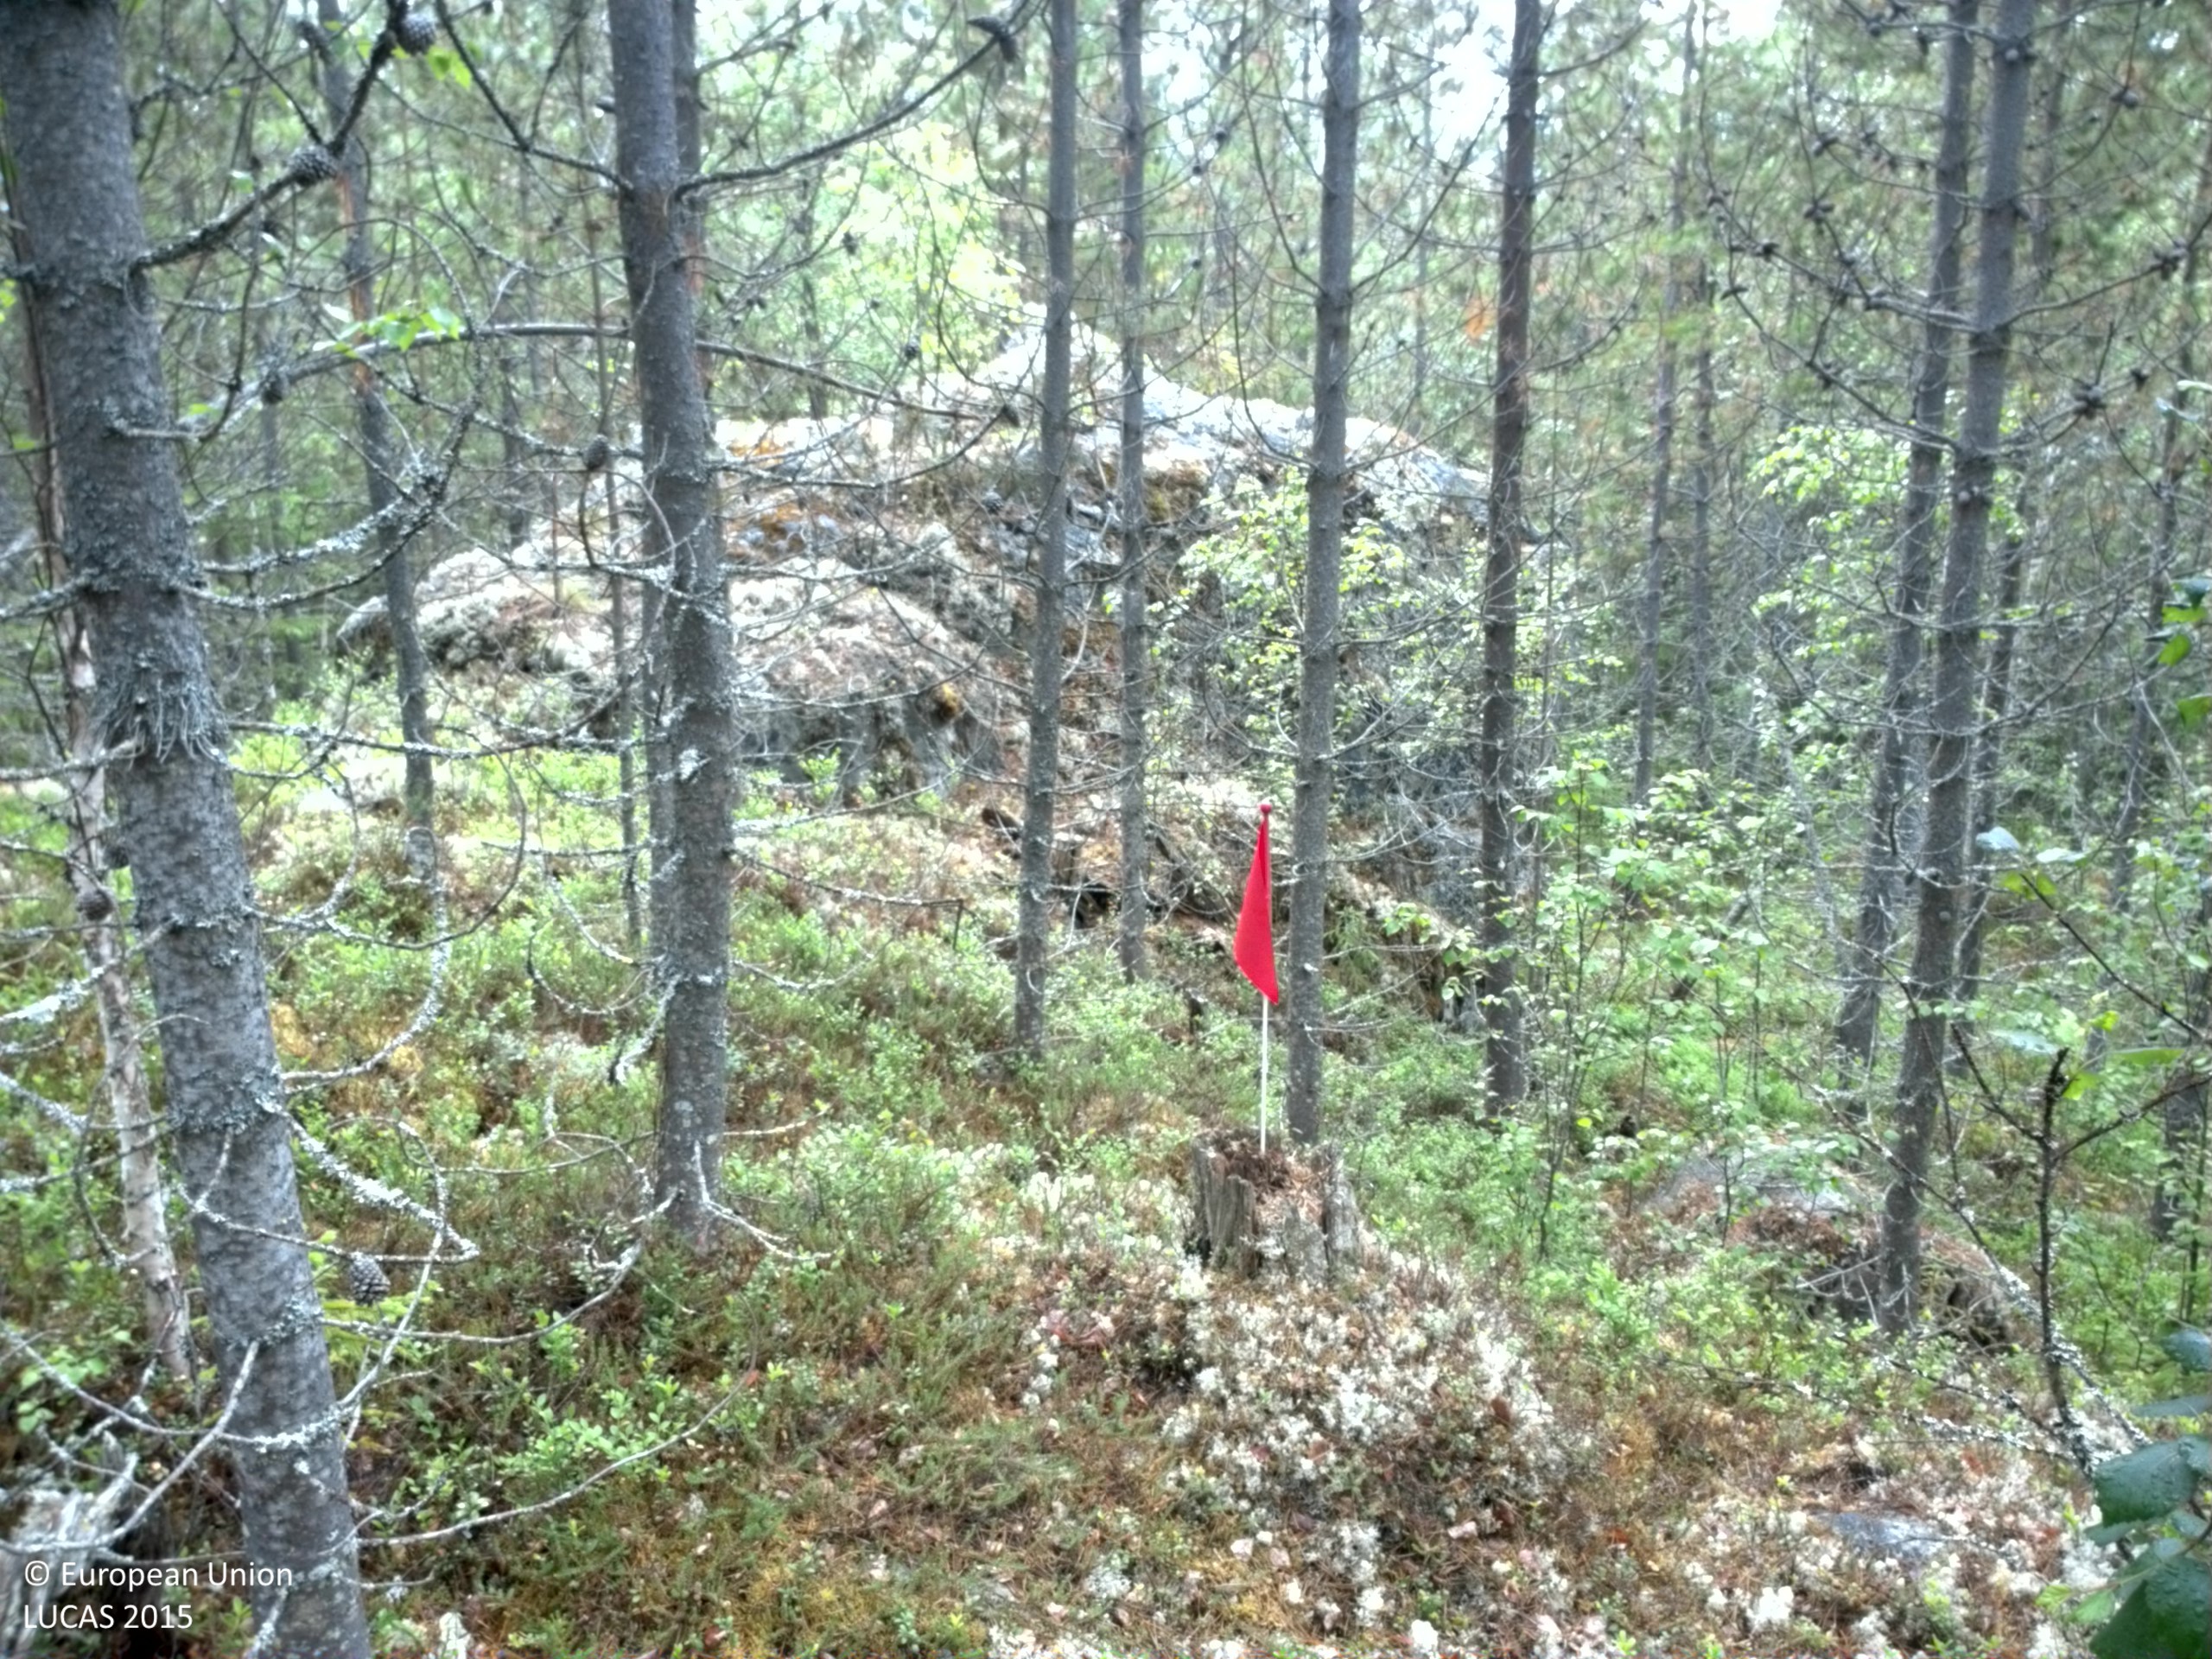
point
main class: Woodland
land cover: Pine dominated coniferous woodland
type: exotic forest
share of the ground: > 75 %
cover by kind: coniferous forest trees 80 %, consolidated bare surface 20 %
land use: Forestry
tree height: > 5 m
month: July
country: SE
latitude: 63.2482
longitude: 17.7220
